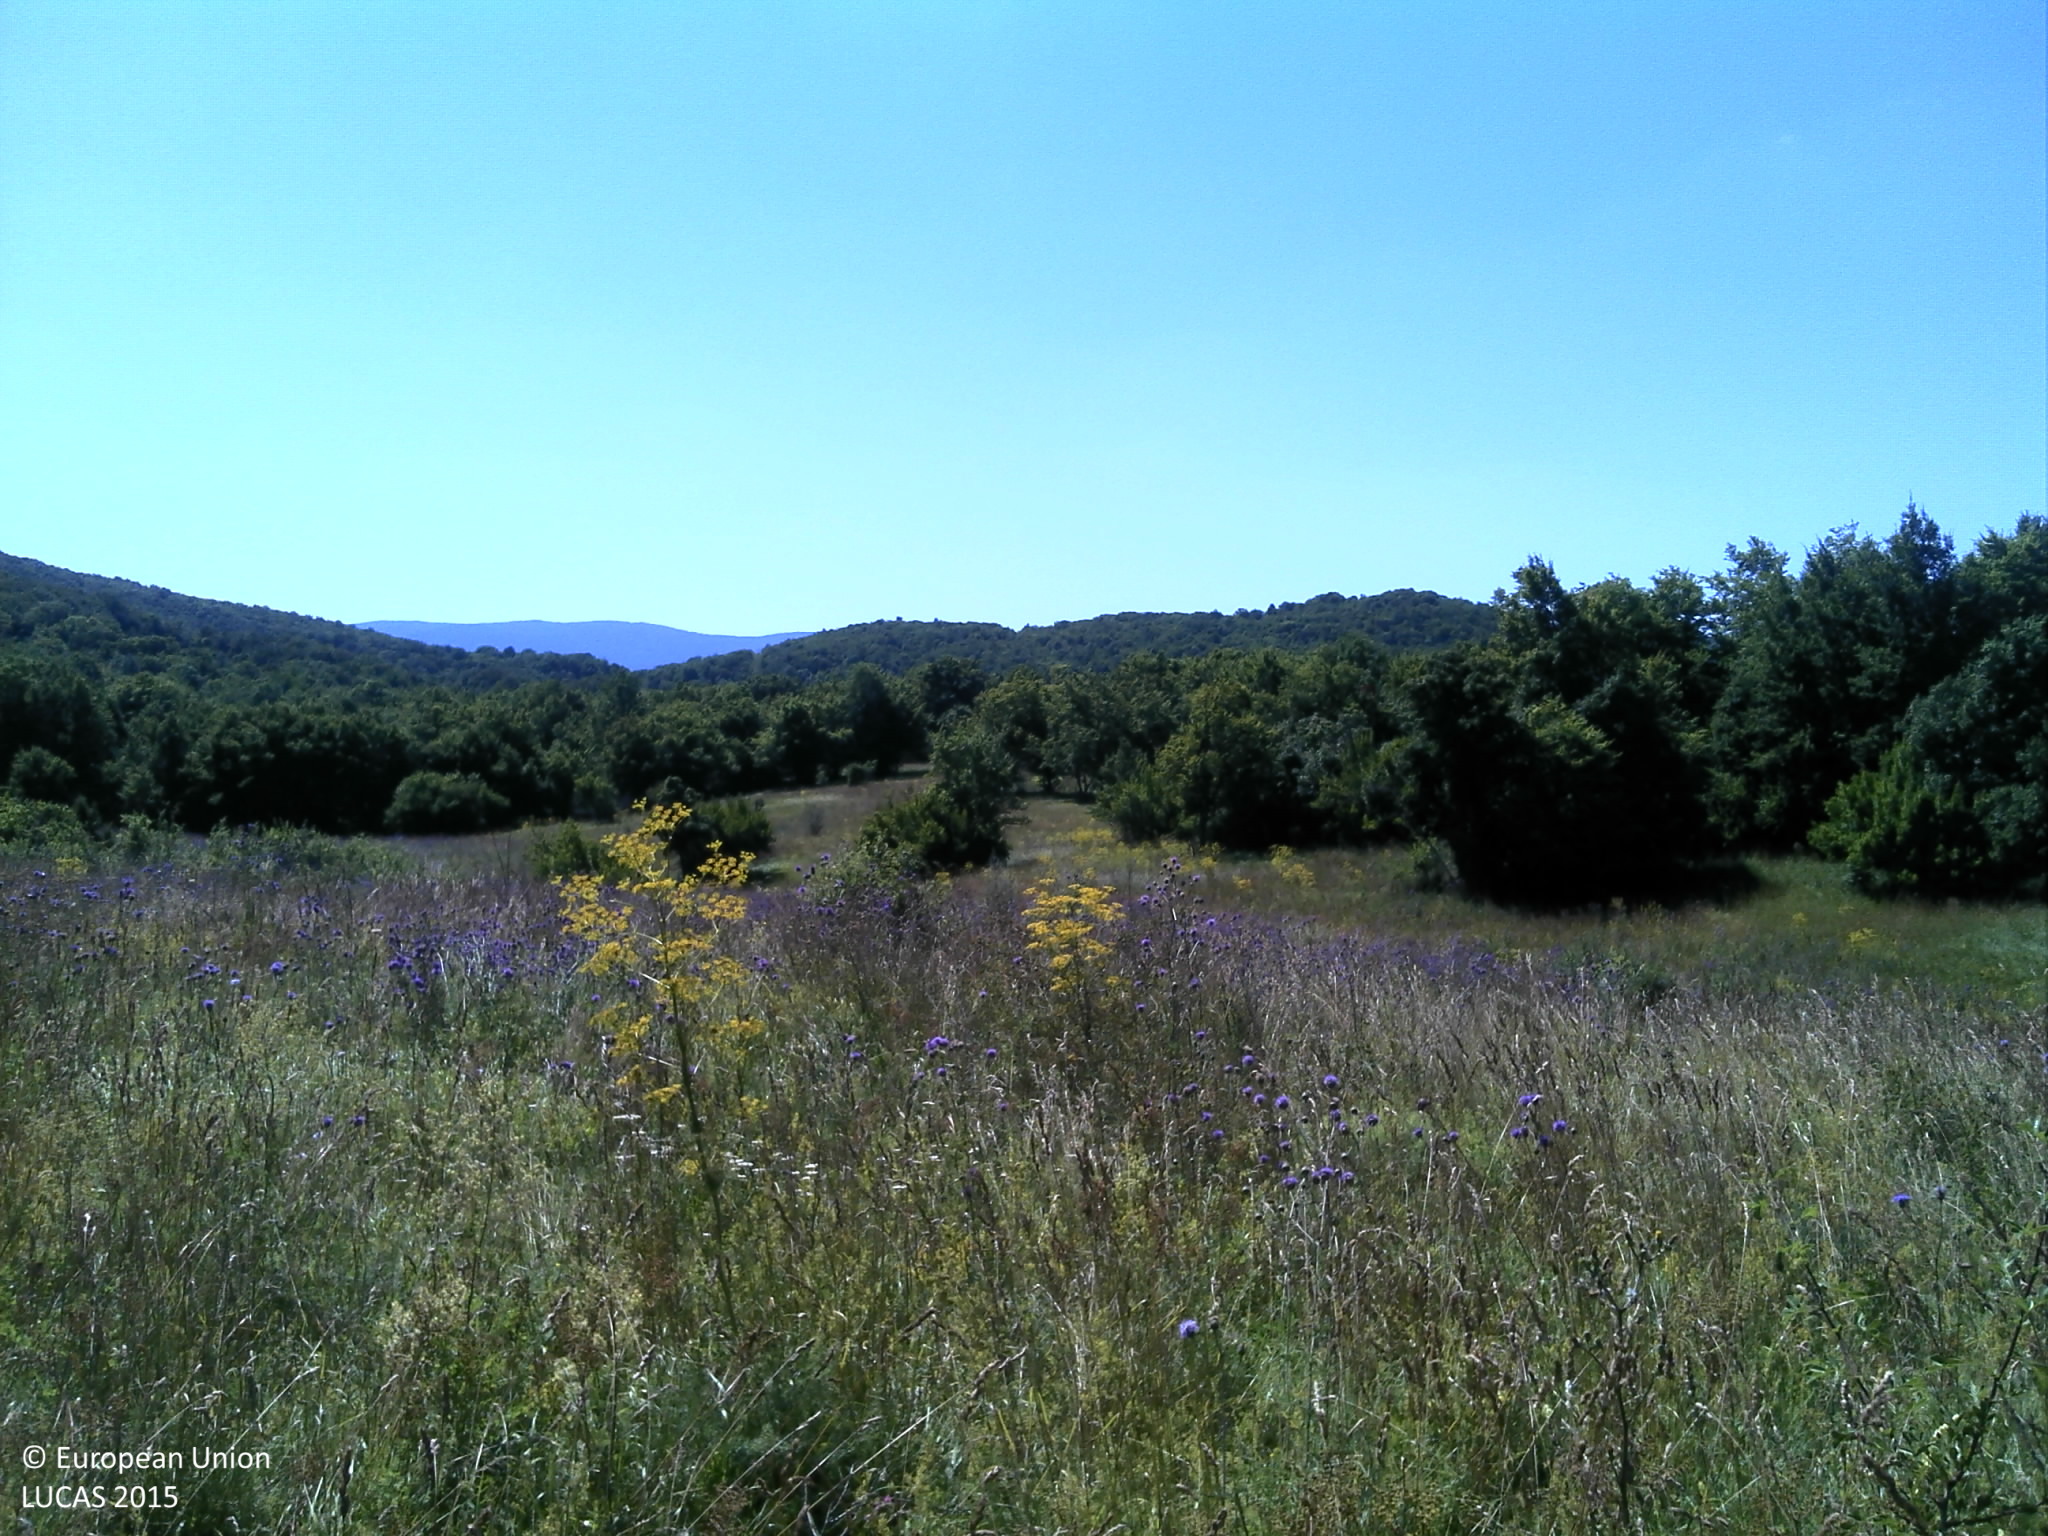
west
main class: Grassland
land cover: Grassland without tree/shrub cover
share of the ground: > 75 %
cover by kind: herbaceous plants 95 %, shrubs 5 %
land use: Semi-natural and natural areas not in use
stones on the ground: < 10 %
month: July
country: HR
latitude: 44.9247
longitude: 15.2014
